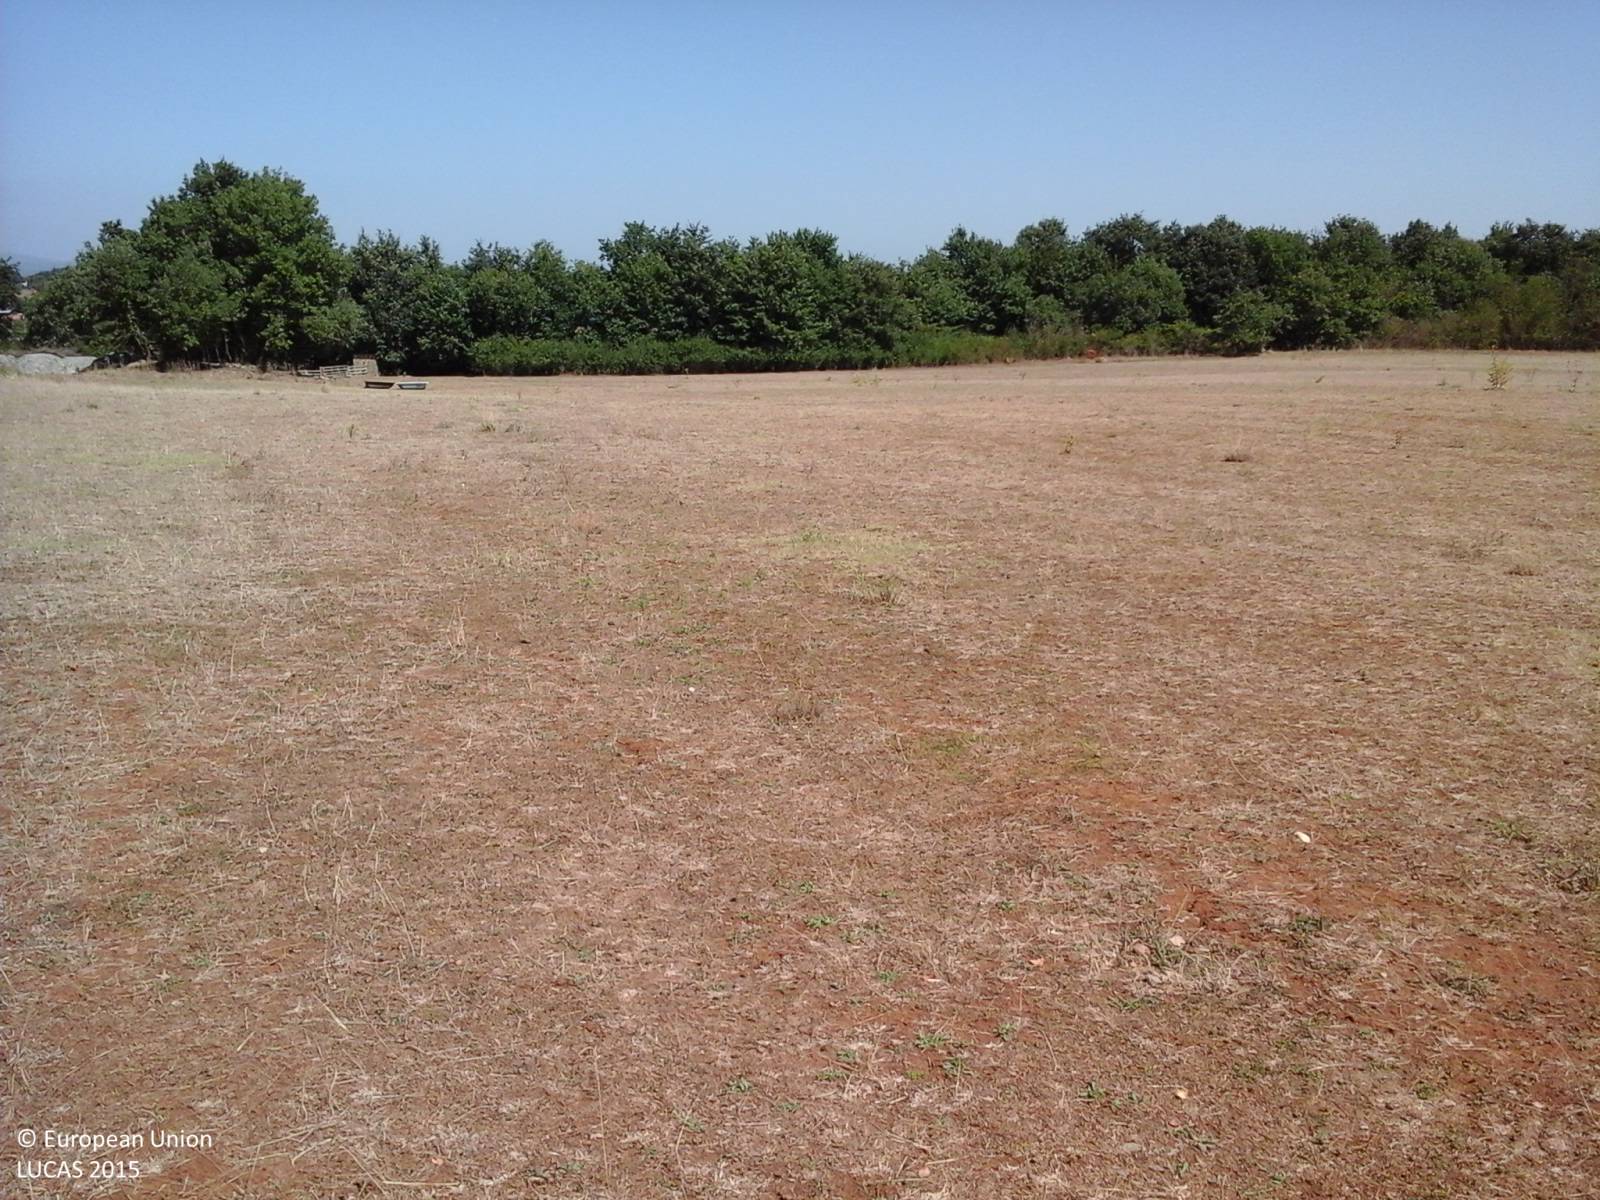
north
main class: Grassland
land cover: Spontaneously vegetated surfaces
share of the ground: > 75 %
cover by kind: herbaceous plants 85 %, consolidated bare surface 15 %
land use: Agriculture (excluding fallow land and kitchen gardens)
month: July
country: IT
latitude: 42.1930
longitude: 12.3530
